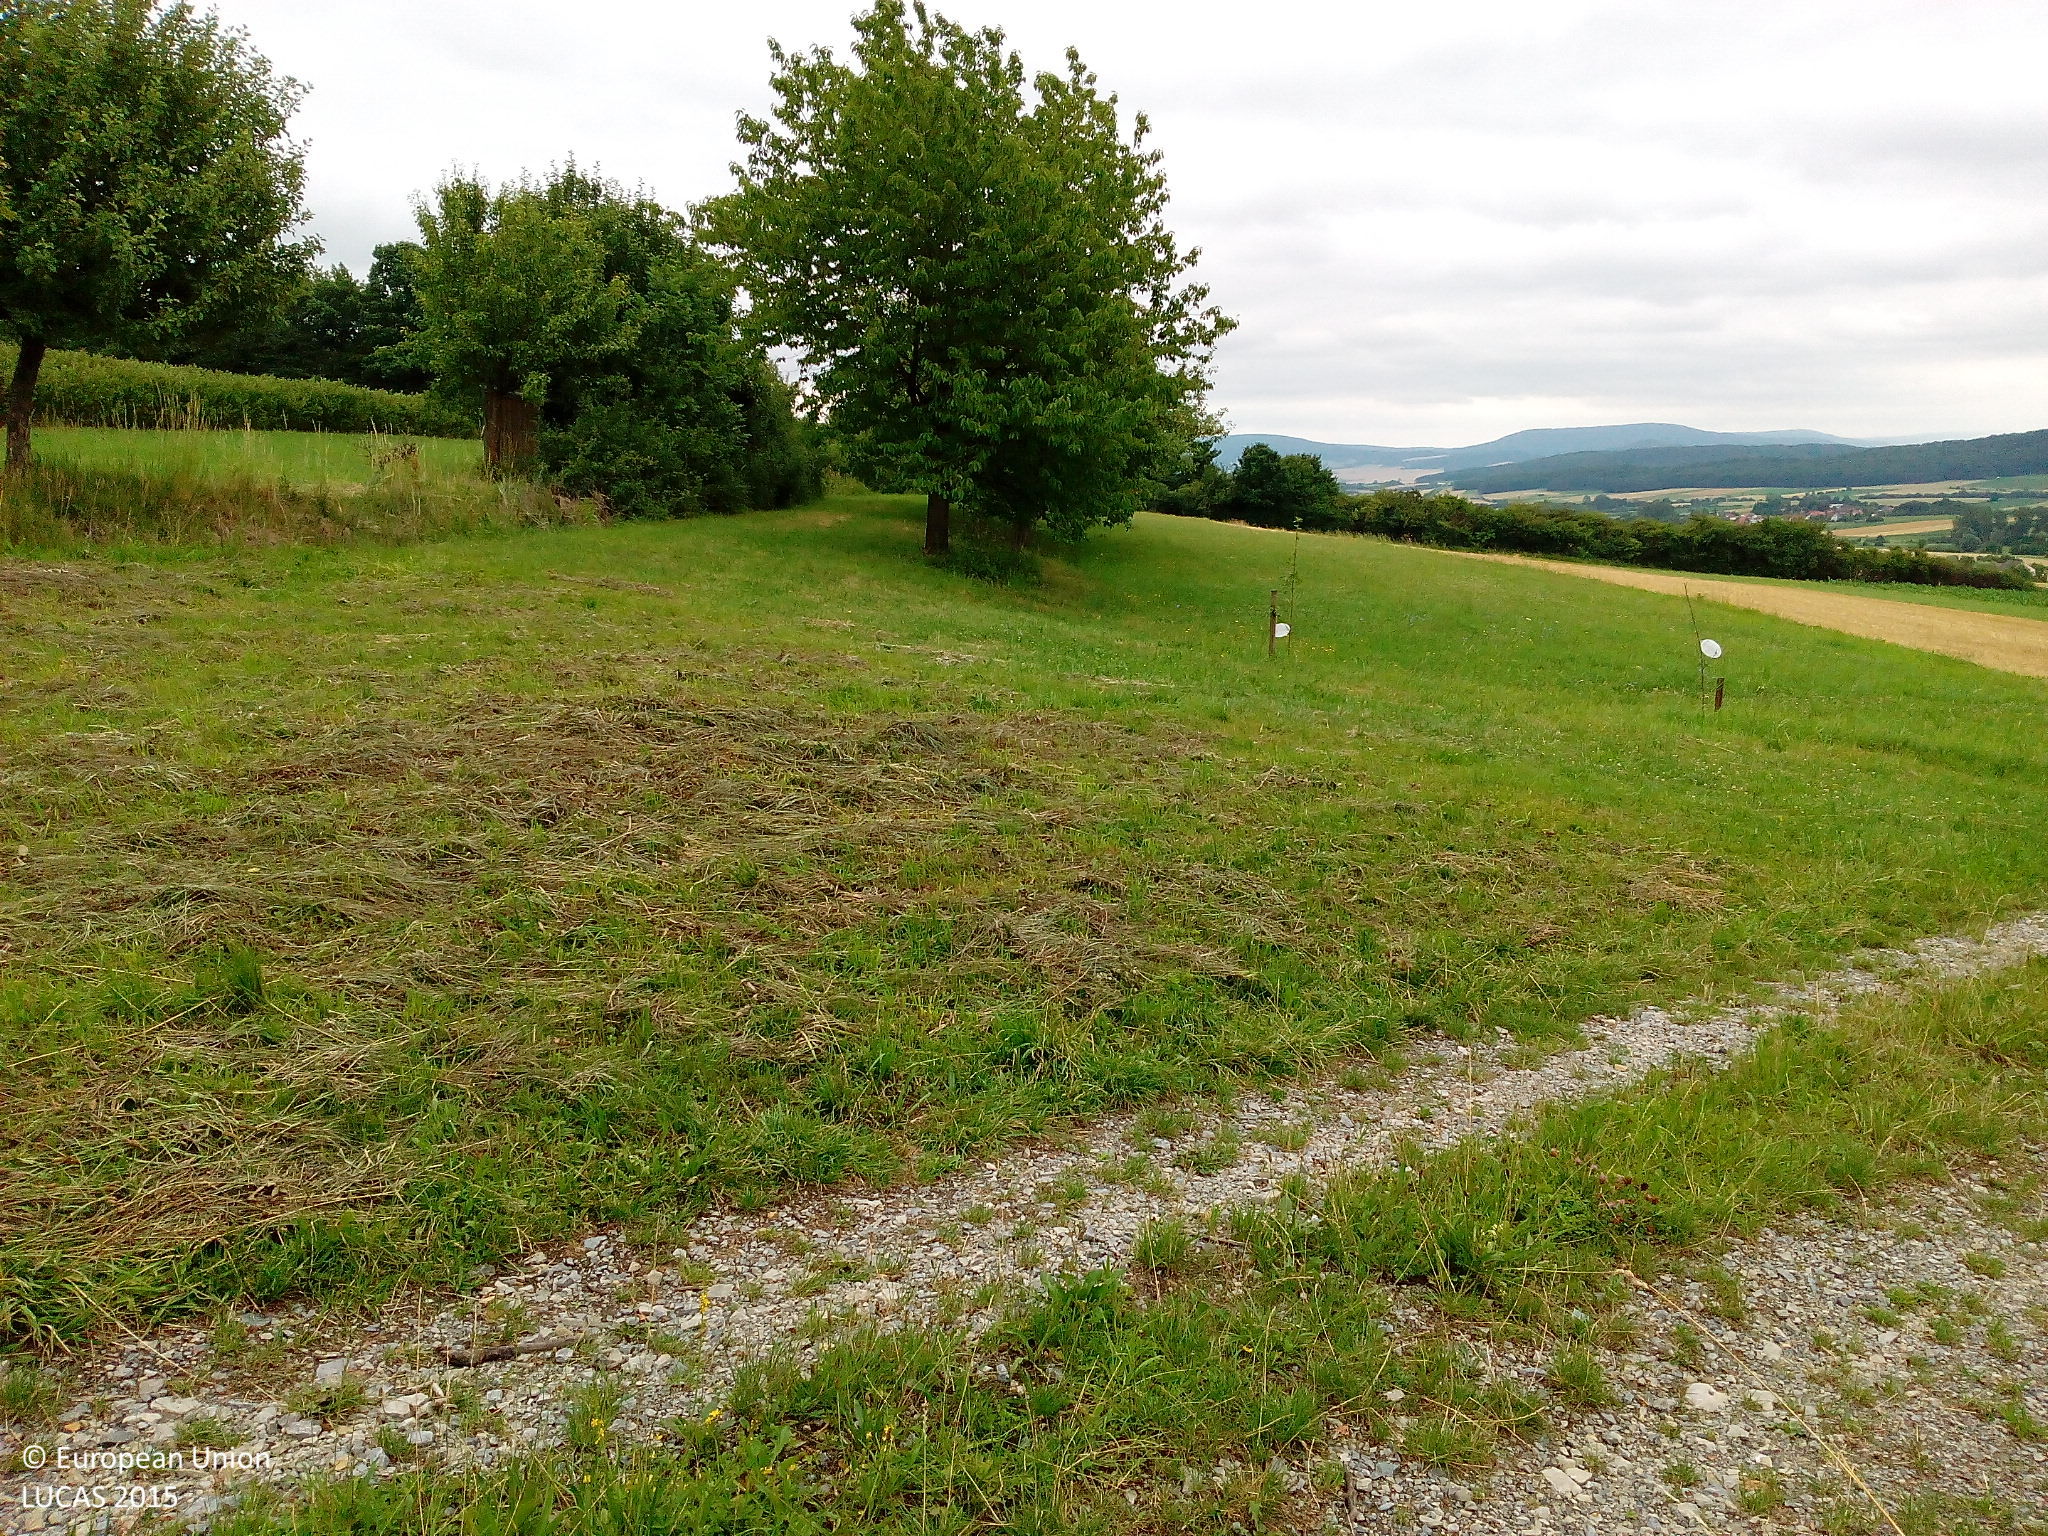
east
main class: Grassland
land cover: Grassland without tree/shrub cover
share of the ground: > 75 %
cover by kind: herbaceous plants 100 %
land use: Agriculture (excluding fallow land and kitchen gardens)
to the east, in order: Grassland without tree/shrub cover; Fences; Broadleaved woodland; Grass margins; Tracks; Grass margins; Ditches and canals; Grassland without tree/shrub cover; Apple fruit; Tracks; Ditches and canals; Managed hedges; Grassland with sparse tree/shrub cover; Tracks; Broadleaved woodland; Fences; Grassland without tree/shrub cover
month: July
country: DE
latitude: 50.7775
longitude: 9.8724
